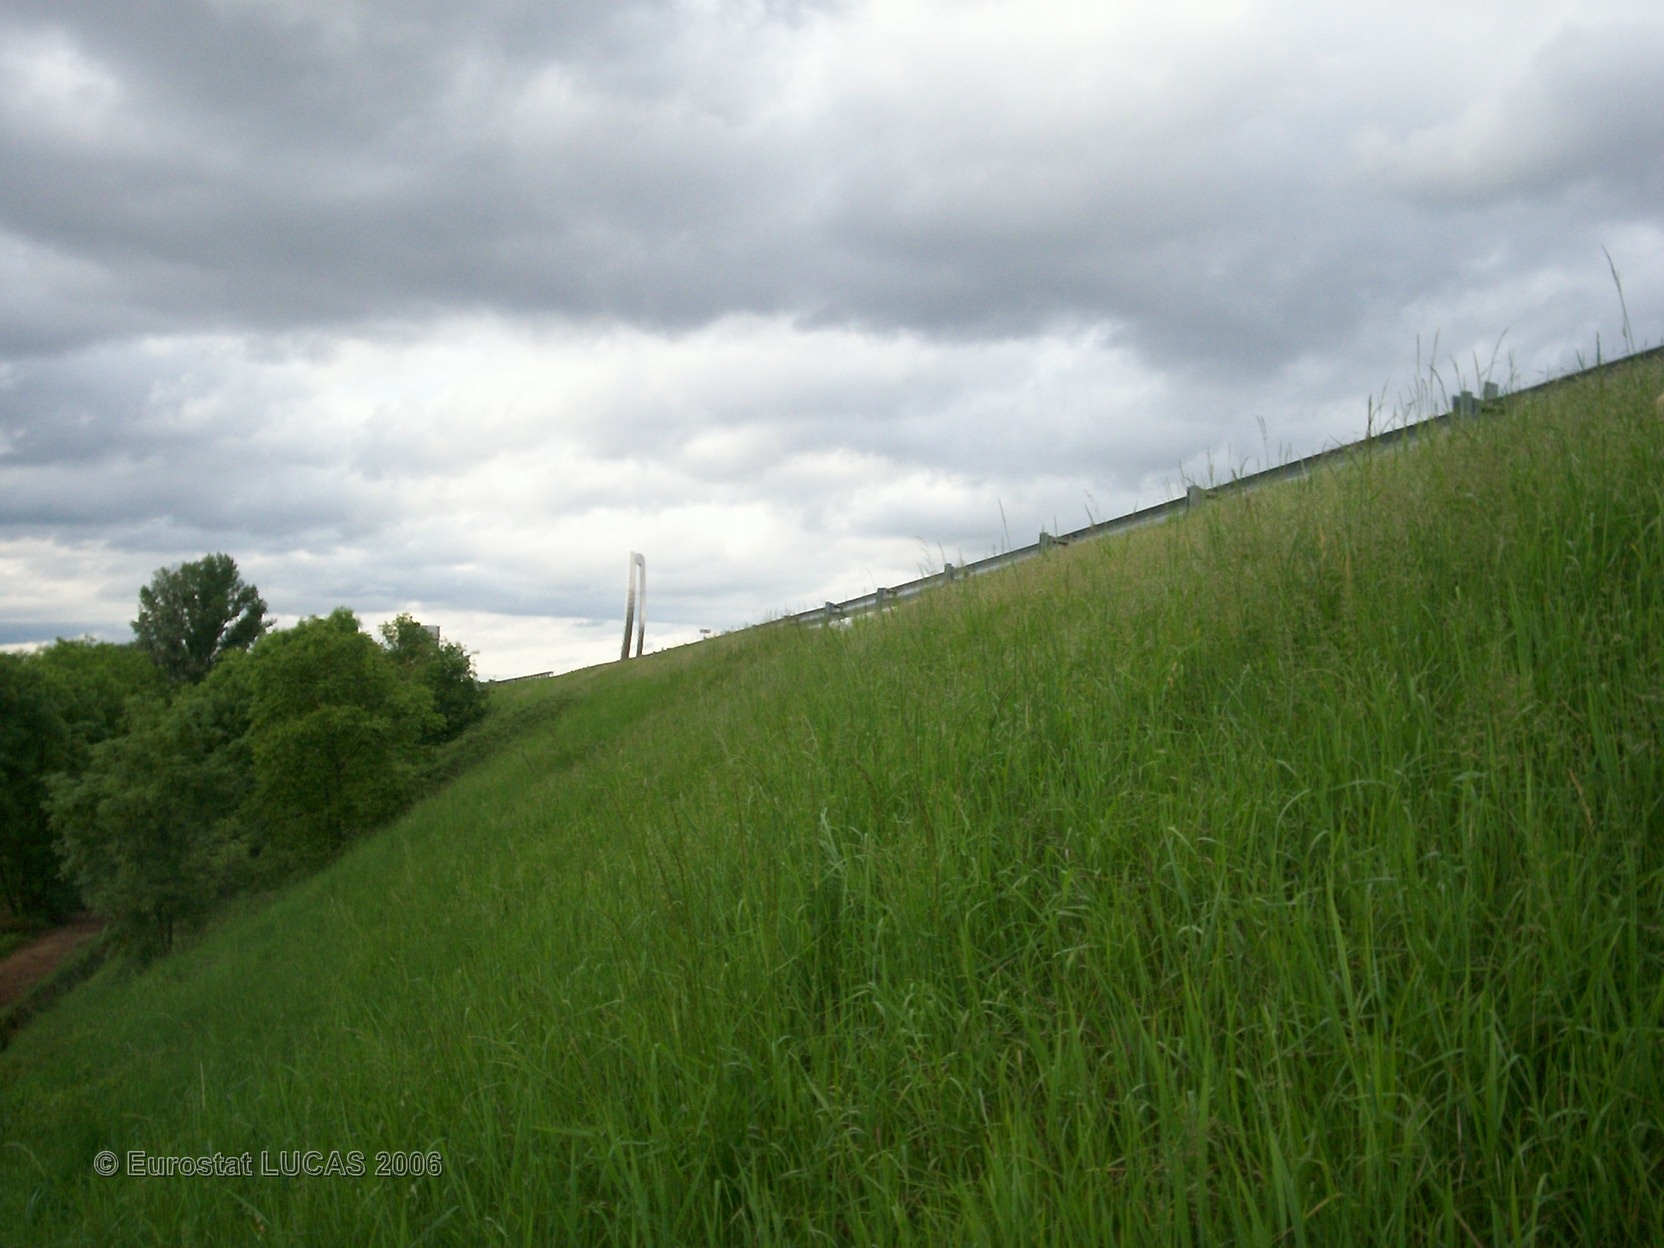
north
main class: Grassland
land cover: Grassland without tree/shrub cover
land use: Unused
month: May
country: FR
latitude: 45.9324
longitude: 4.7282
